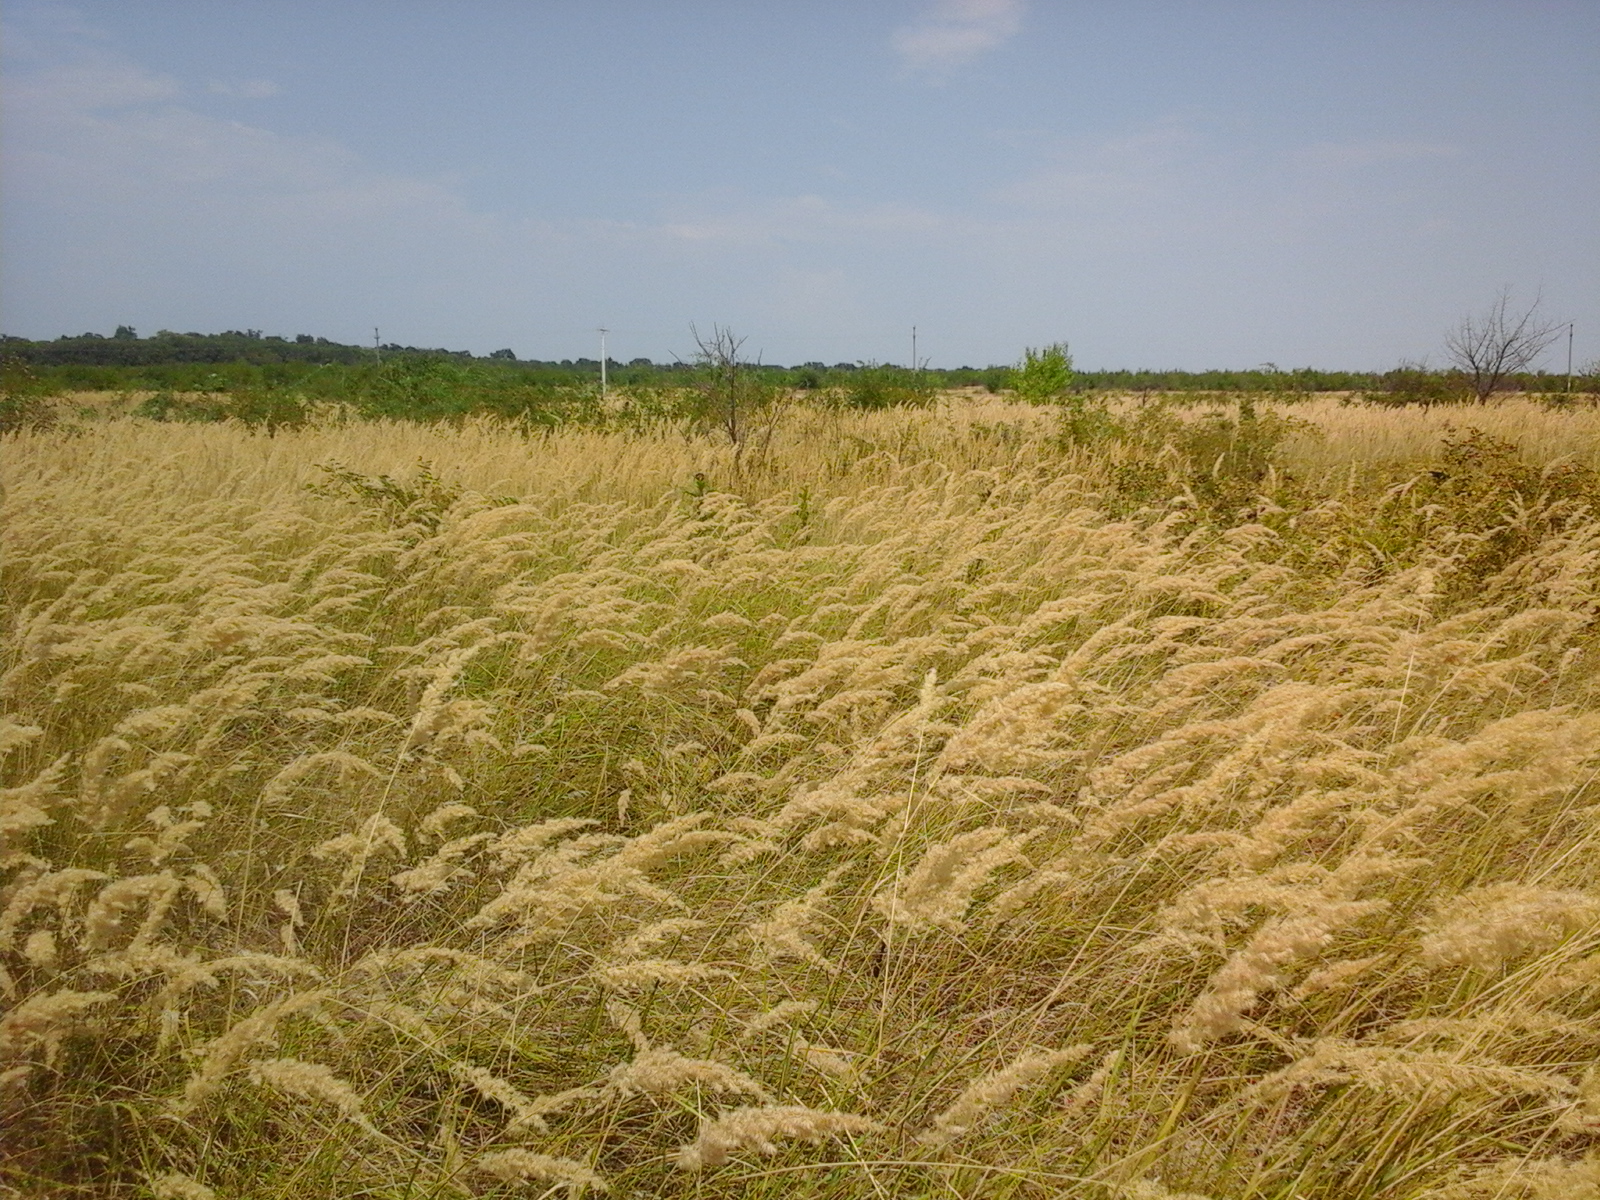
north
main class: Grassland
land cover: Grassland with sparse tree/shrub cover
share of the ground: > 75 %
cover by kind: herbaceous plants 85 %, shrubs 10 %, broadleaved forest trees 5 %
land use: Fallow land
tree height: < 5 m
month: August
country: RO
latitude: 44.4699
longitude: 22.6229
